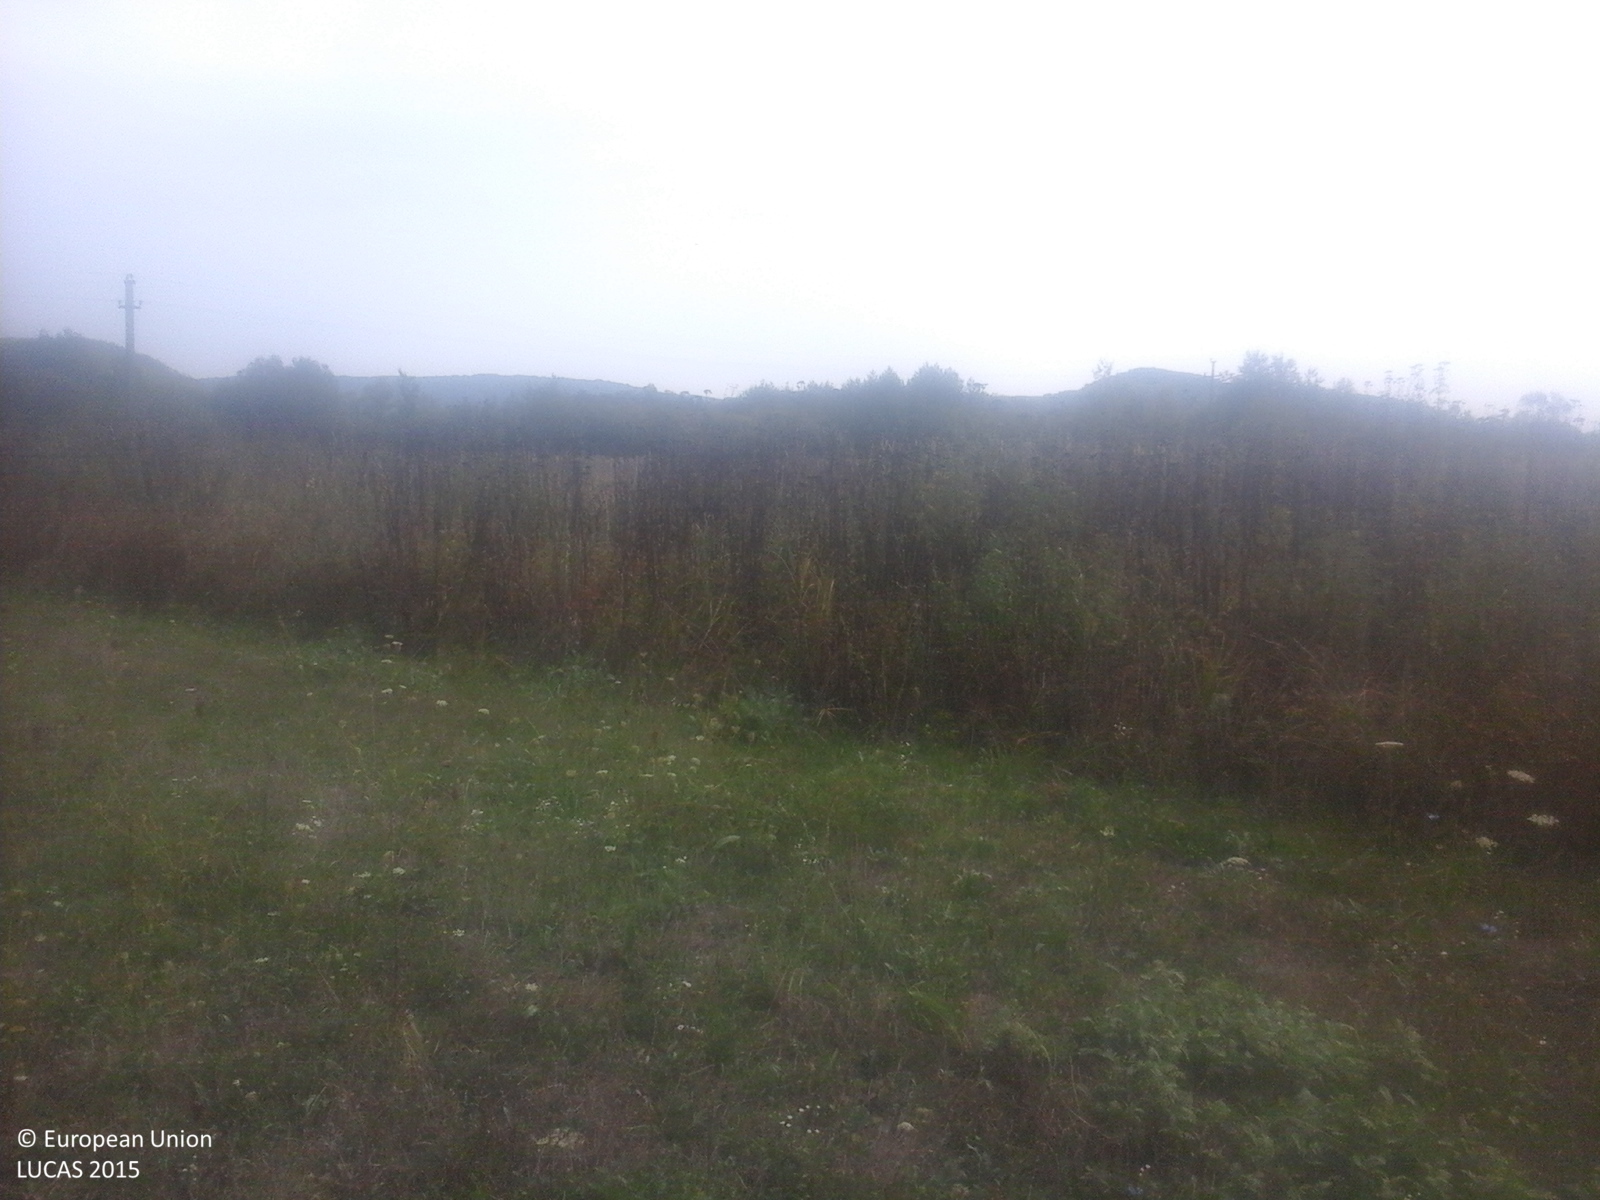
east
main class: Grassland
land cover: Grassland without tree/shrub cover
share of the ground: > 75 %
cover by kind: herbaceous plants 100 %
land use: Agriculture (excluding fallow land and kitchen gardens)
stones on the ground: < 10 %
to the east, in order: Grassland without tree/shrub cover; Shruby margins; Ditches and canals; Spontaneously vegetated surfaces; Grassland without tree/shrub cover; Spontaneously vegetated surfaces; Maize; Electric lines; Maize; Grassland without tree/shrub cover; Tracks; Abandoned hedges; Ditches and canals; Abandoned hedges; Grassland with sparse tree/shrub cover; Arable land (only in case pi); Single bushes/trees; Arable land (only in case pi); Lines of trees; Arable land (only in case pi)
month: September
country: RO
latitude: 45.4402
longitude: 21.9653
